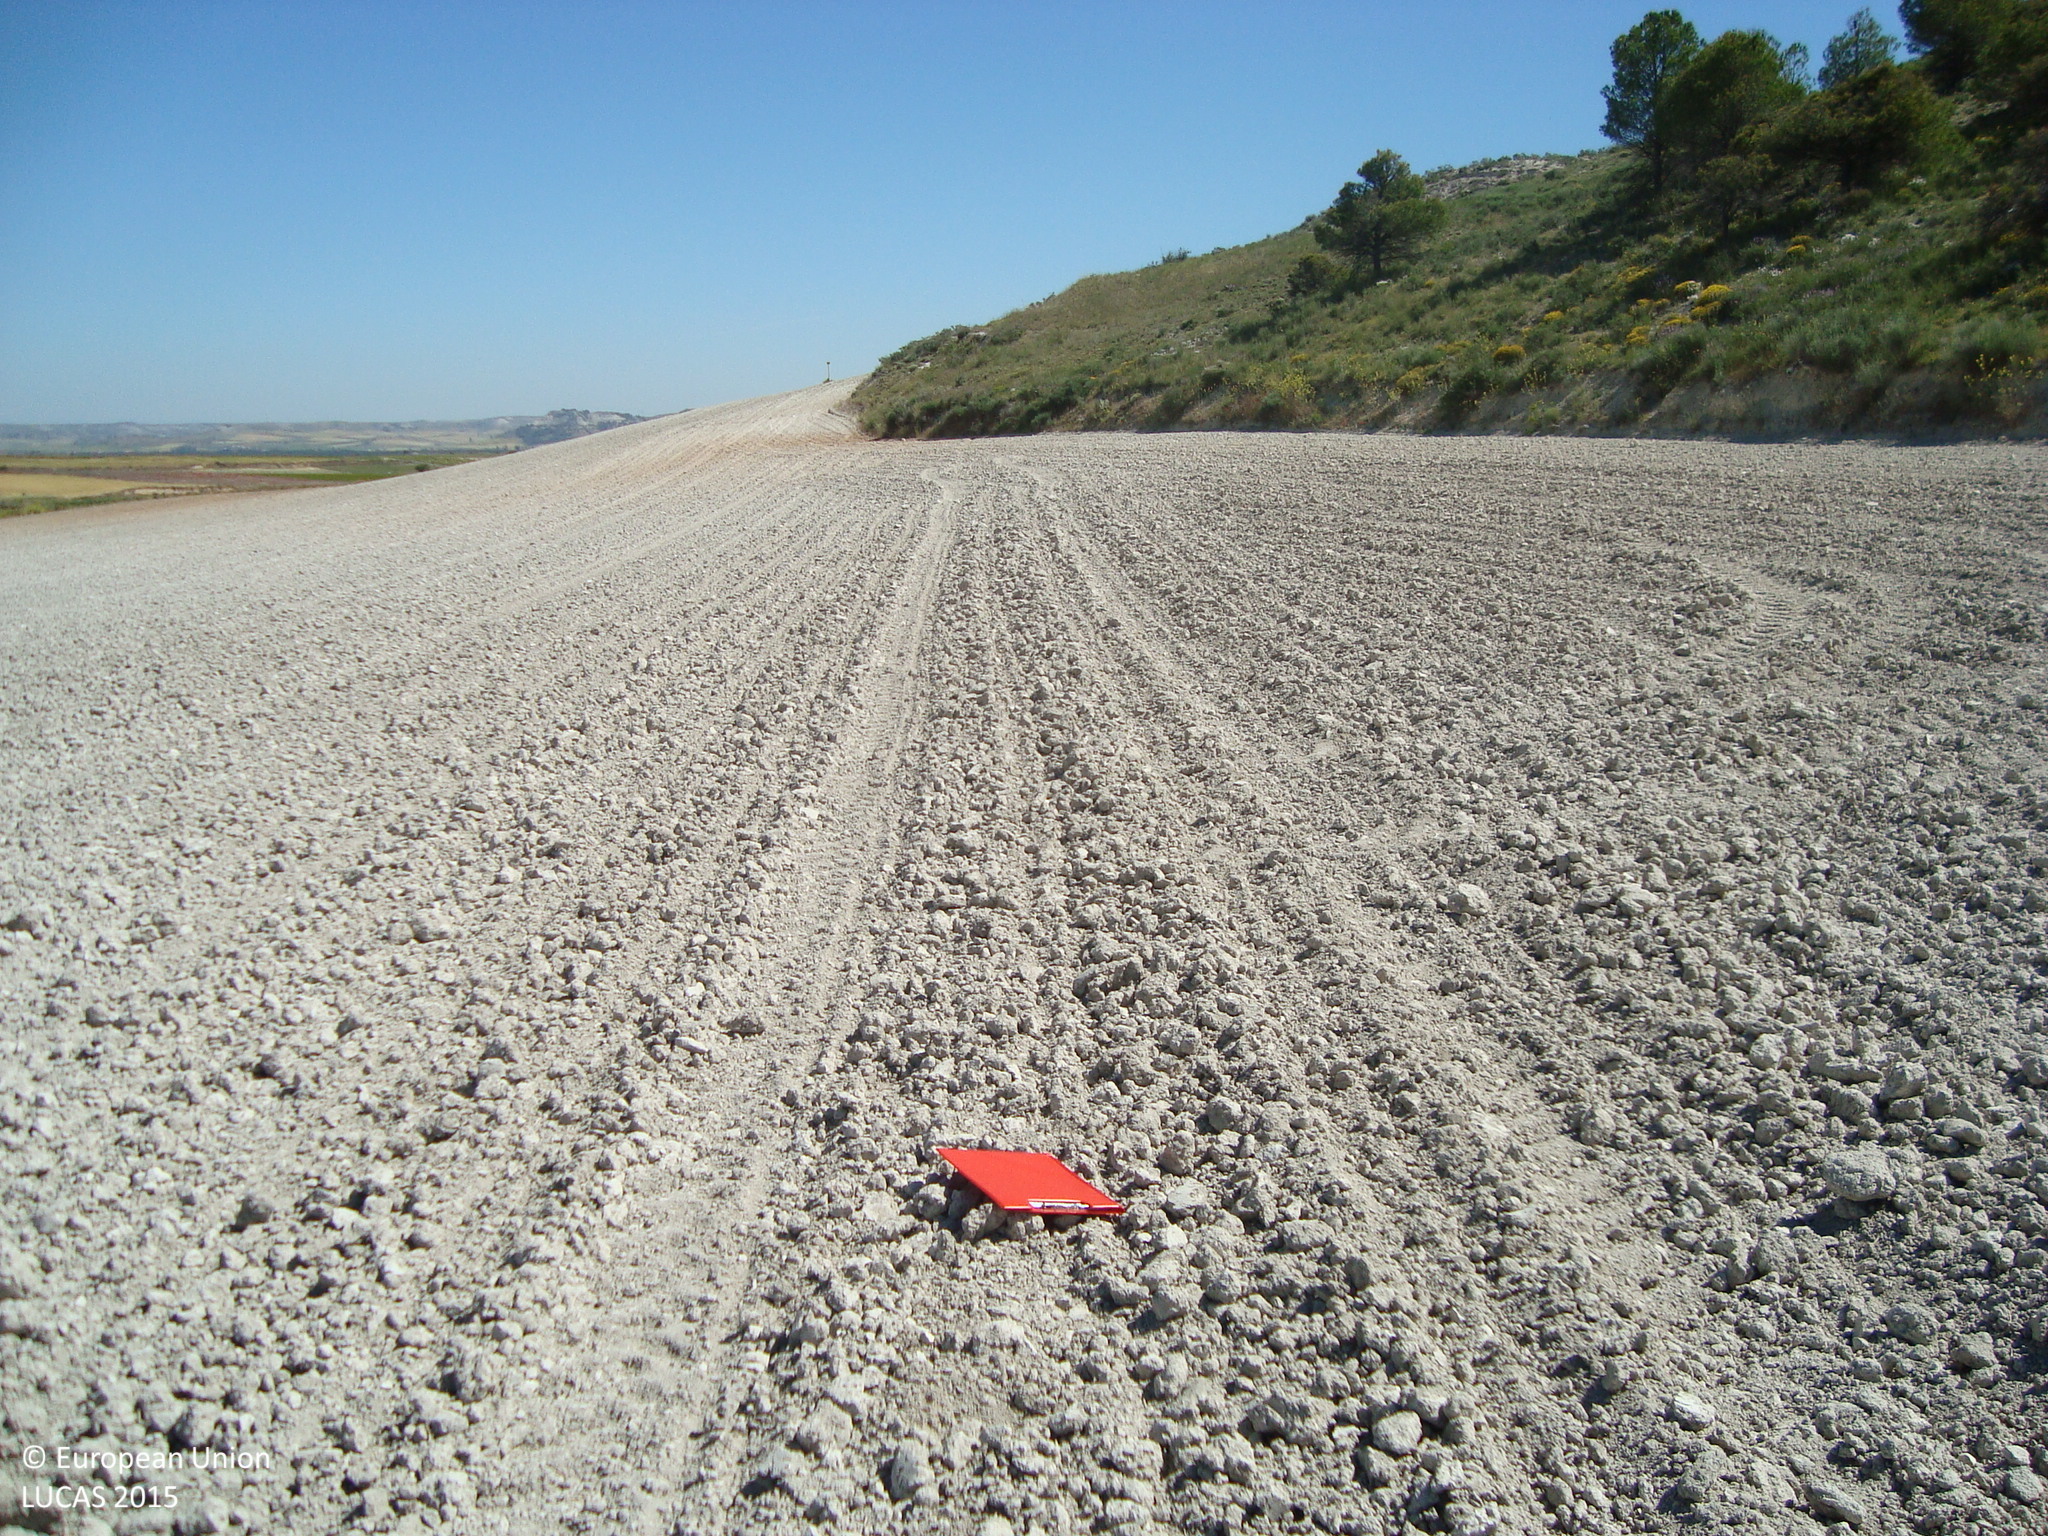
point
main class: Cropland
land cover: Sunflower
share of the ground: < 10 %
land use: Agriculture (excluding fallow land and kitchen gardens)
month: May
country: ES
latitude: 41.5814
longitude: -4.1523
